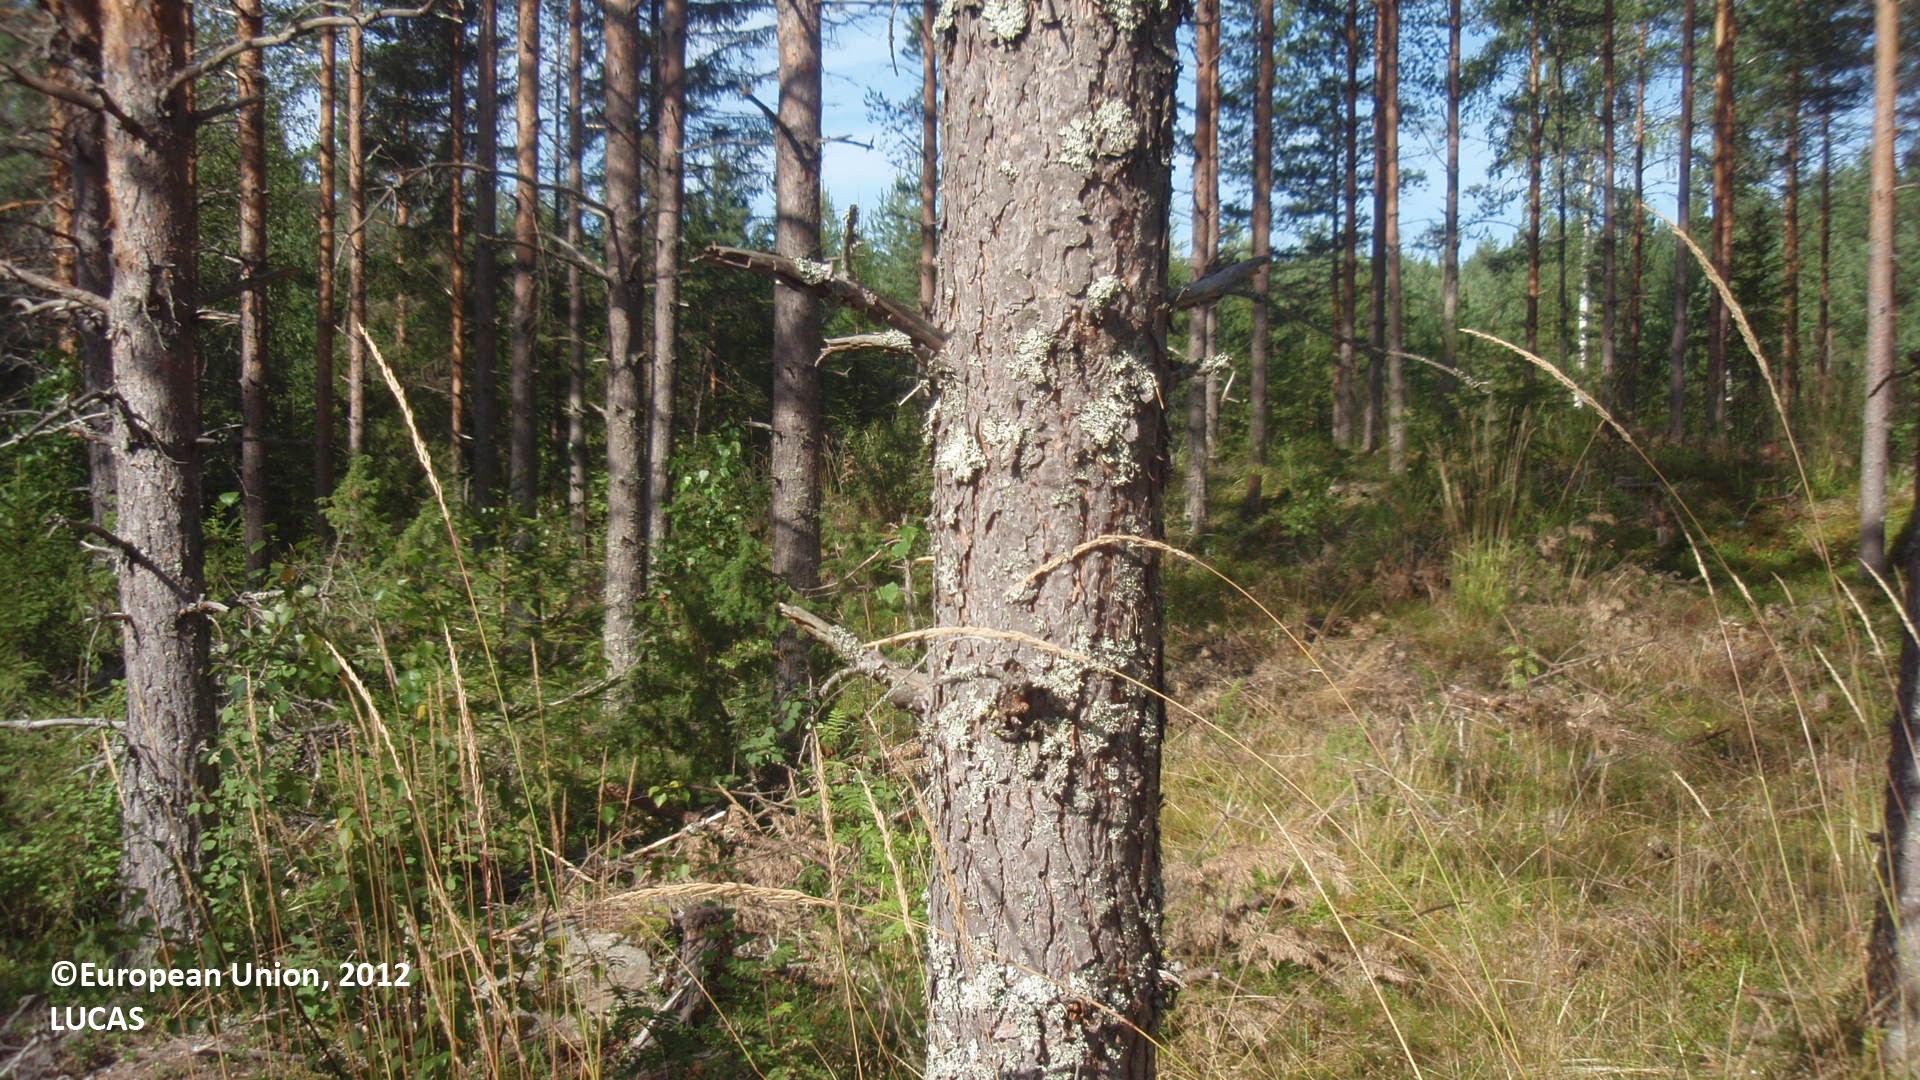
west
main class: Woodland
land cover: Pine dominated coniferous woodland
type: boreal forest
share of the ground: 50 - 75 %
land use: Forestry
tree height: > 5 m
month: August
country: FI
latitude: 61.3635
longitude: 27.2485
